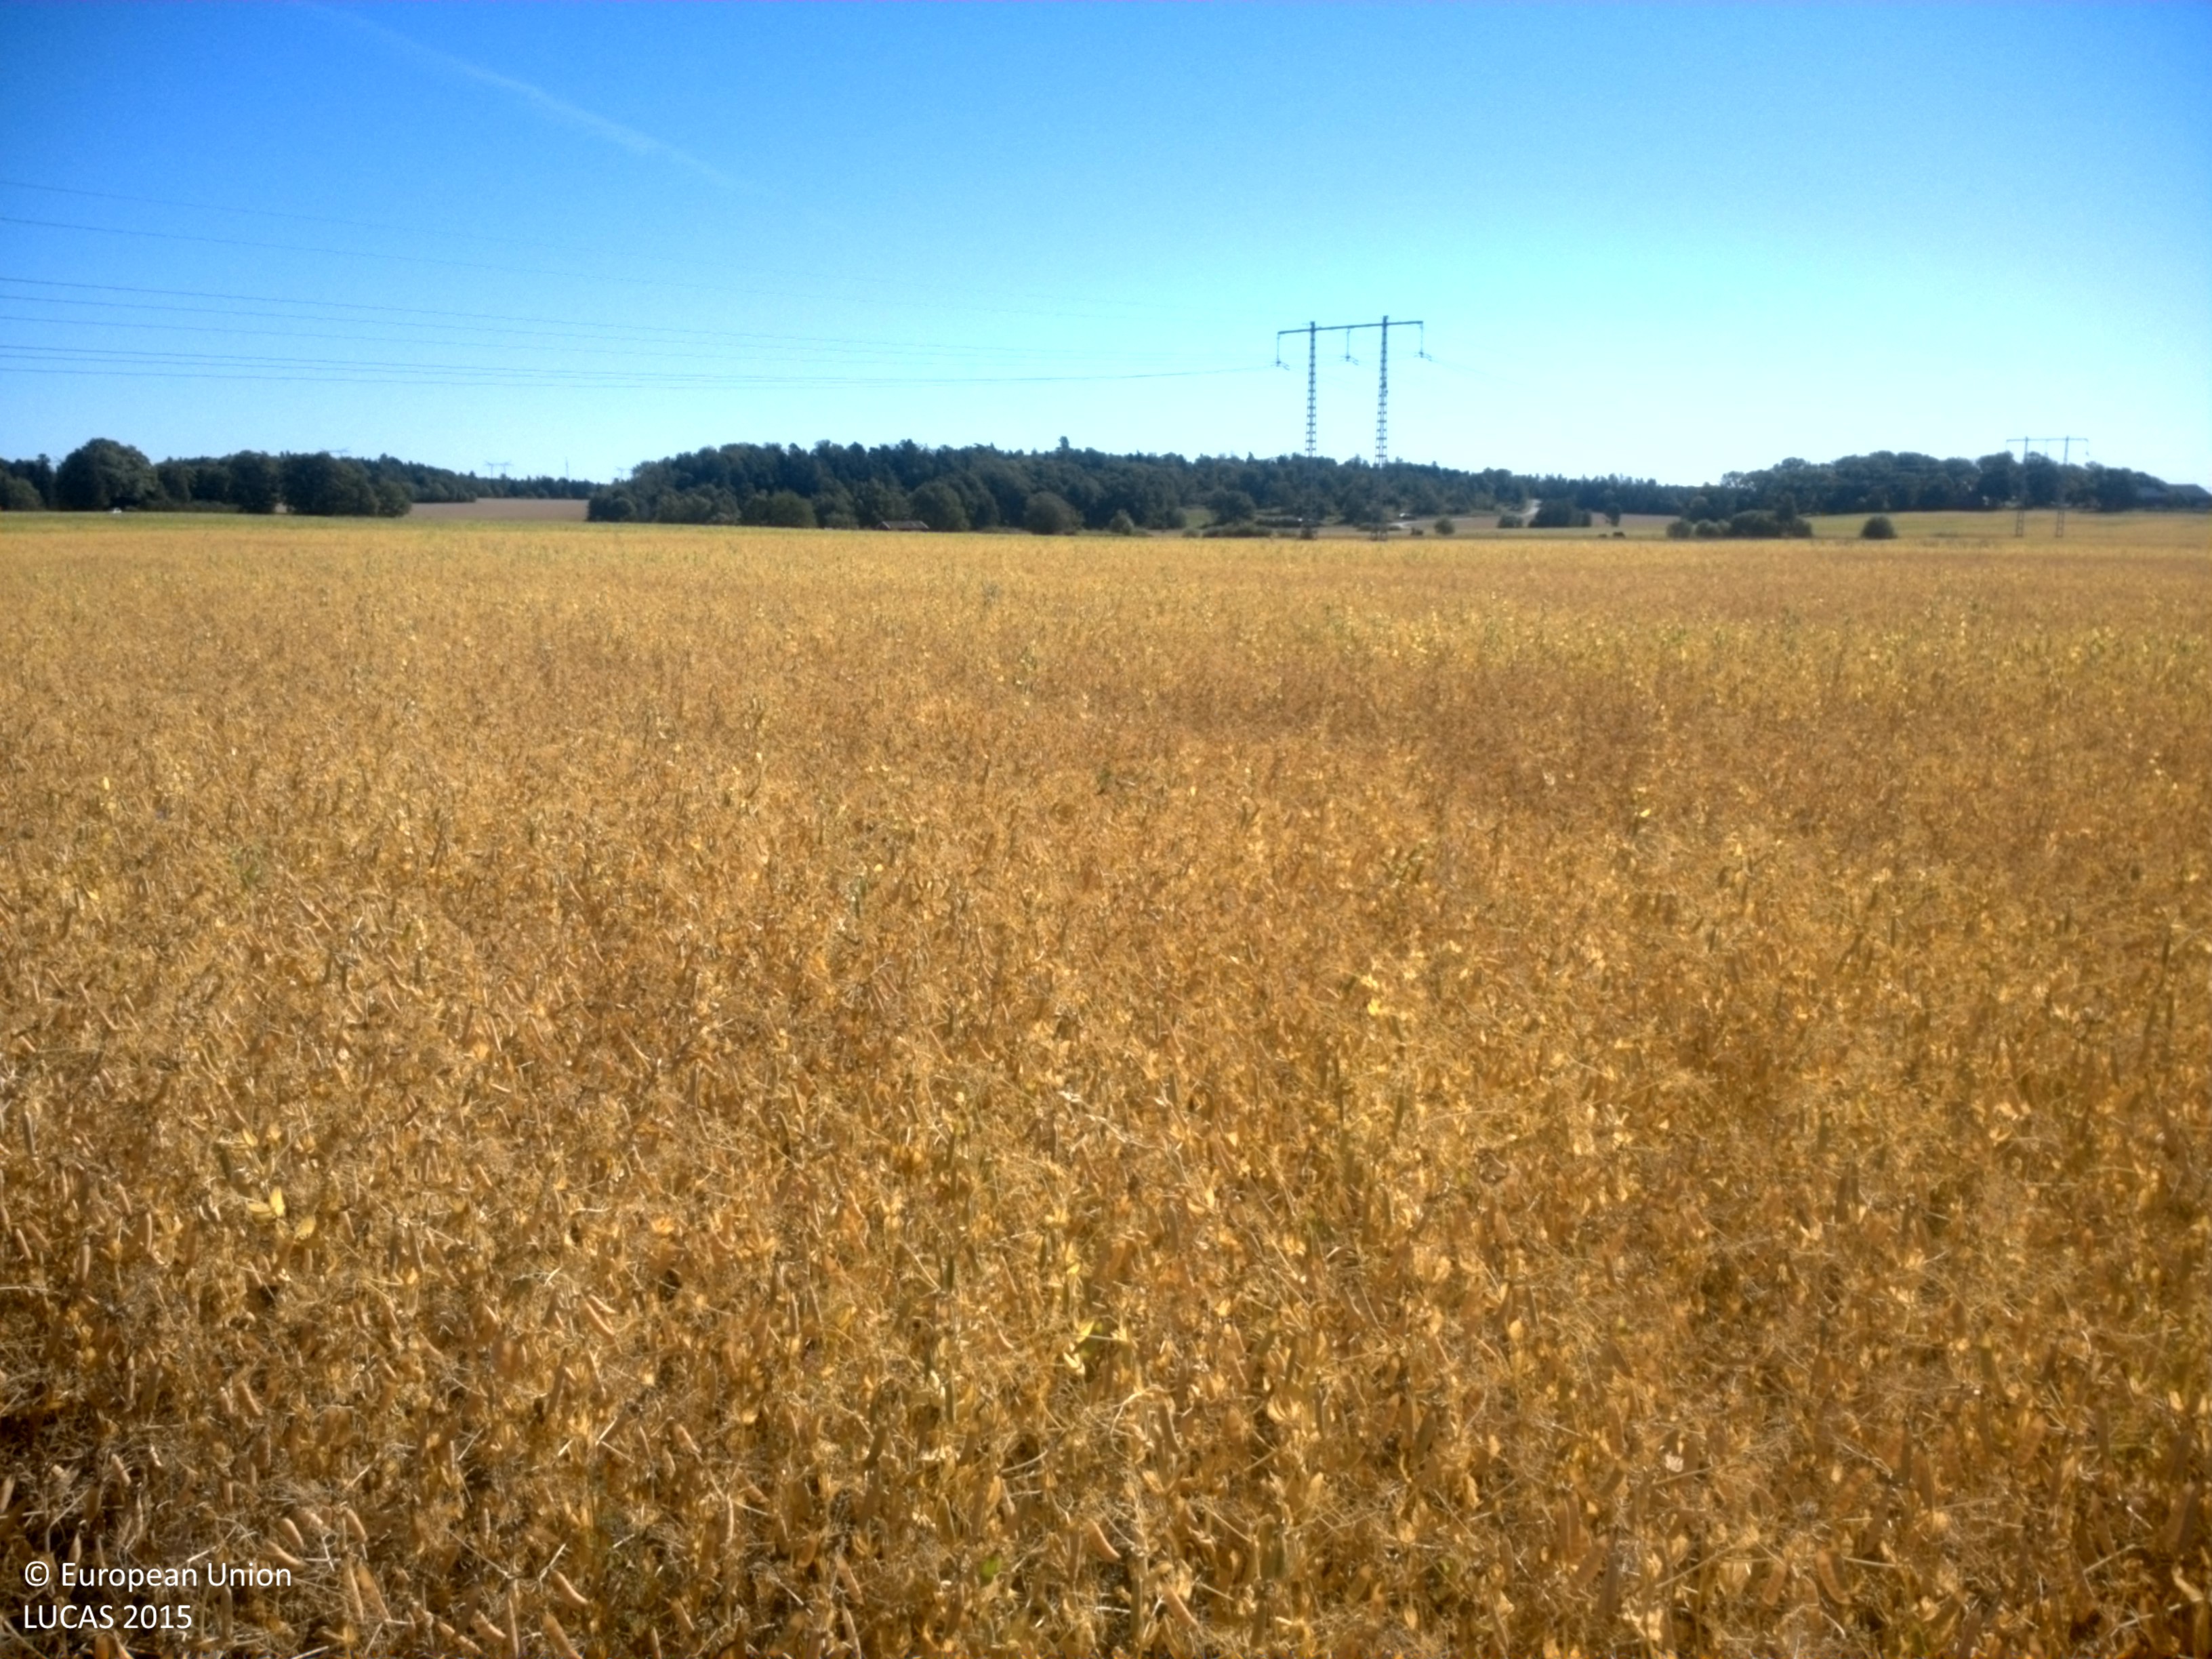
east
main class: Cropland
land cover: Dry pulses
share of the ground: > 75 %
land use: Agriculture (excluding fallow land and kitchen gardens)
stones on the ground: < 10 %
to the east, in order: Dry pulses; Electric lines; Dry pulses
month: August
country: SE
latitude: 59.7239
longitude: 17.2309
